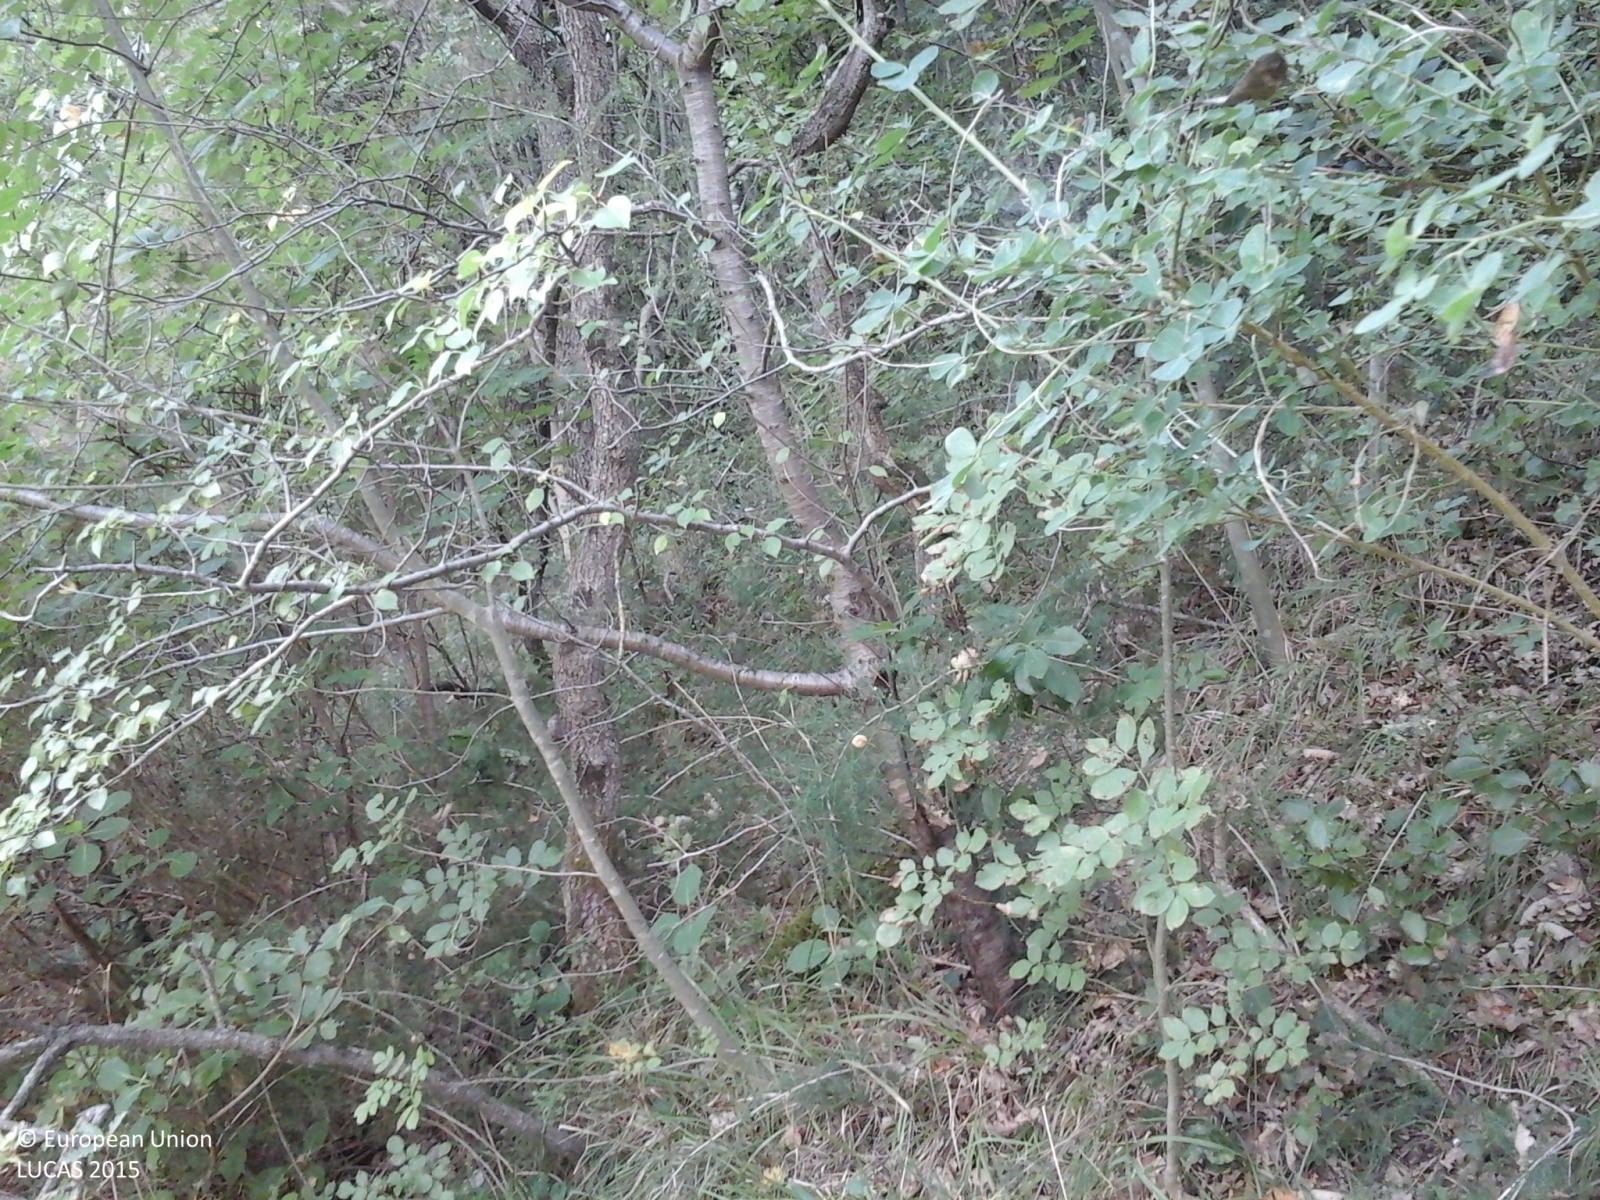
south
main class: Woodland
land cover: Broadleaved woodland
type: thermophilous deciduous forest
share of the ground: > 75 %
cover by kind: broadleaved forest trees 95 %, shrubs 5 %
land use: Forestry
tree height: > 5 m
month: August
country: IT
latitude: 43.3687
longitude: 12.9910
